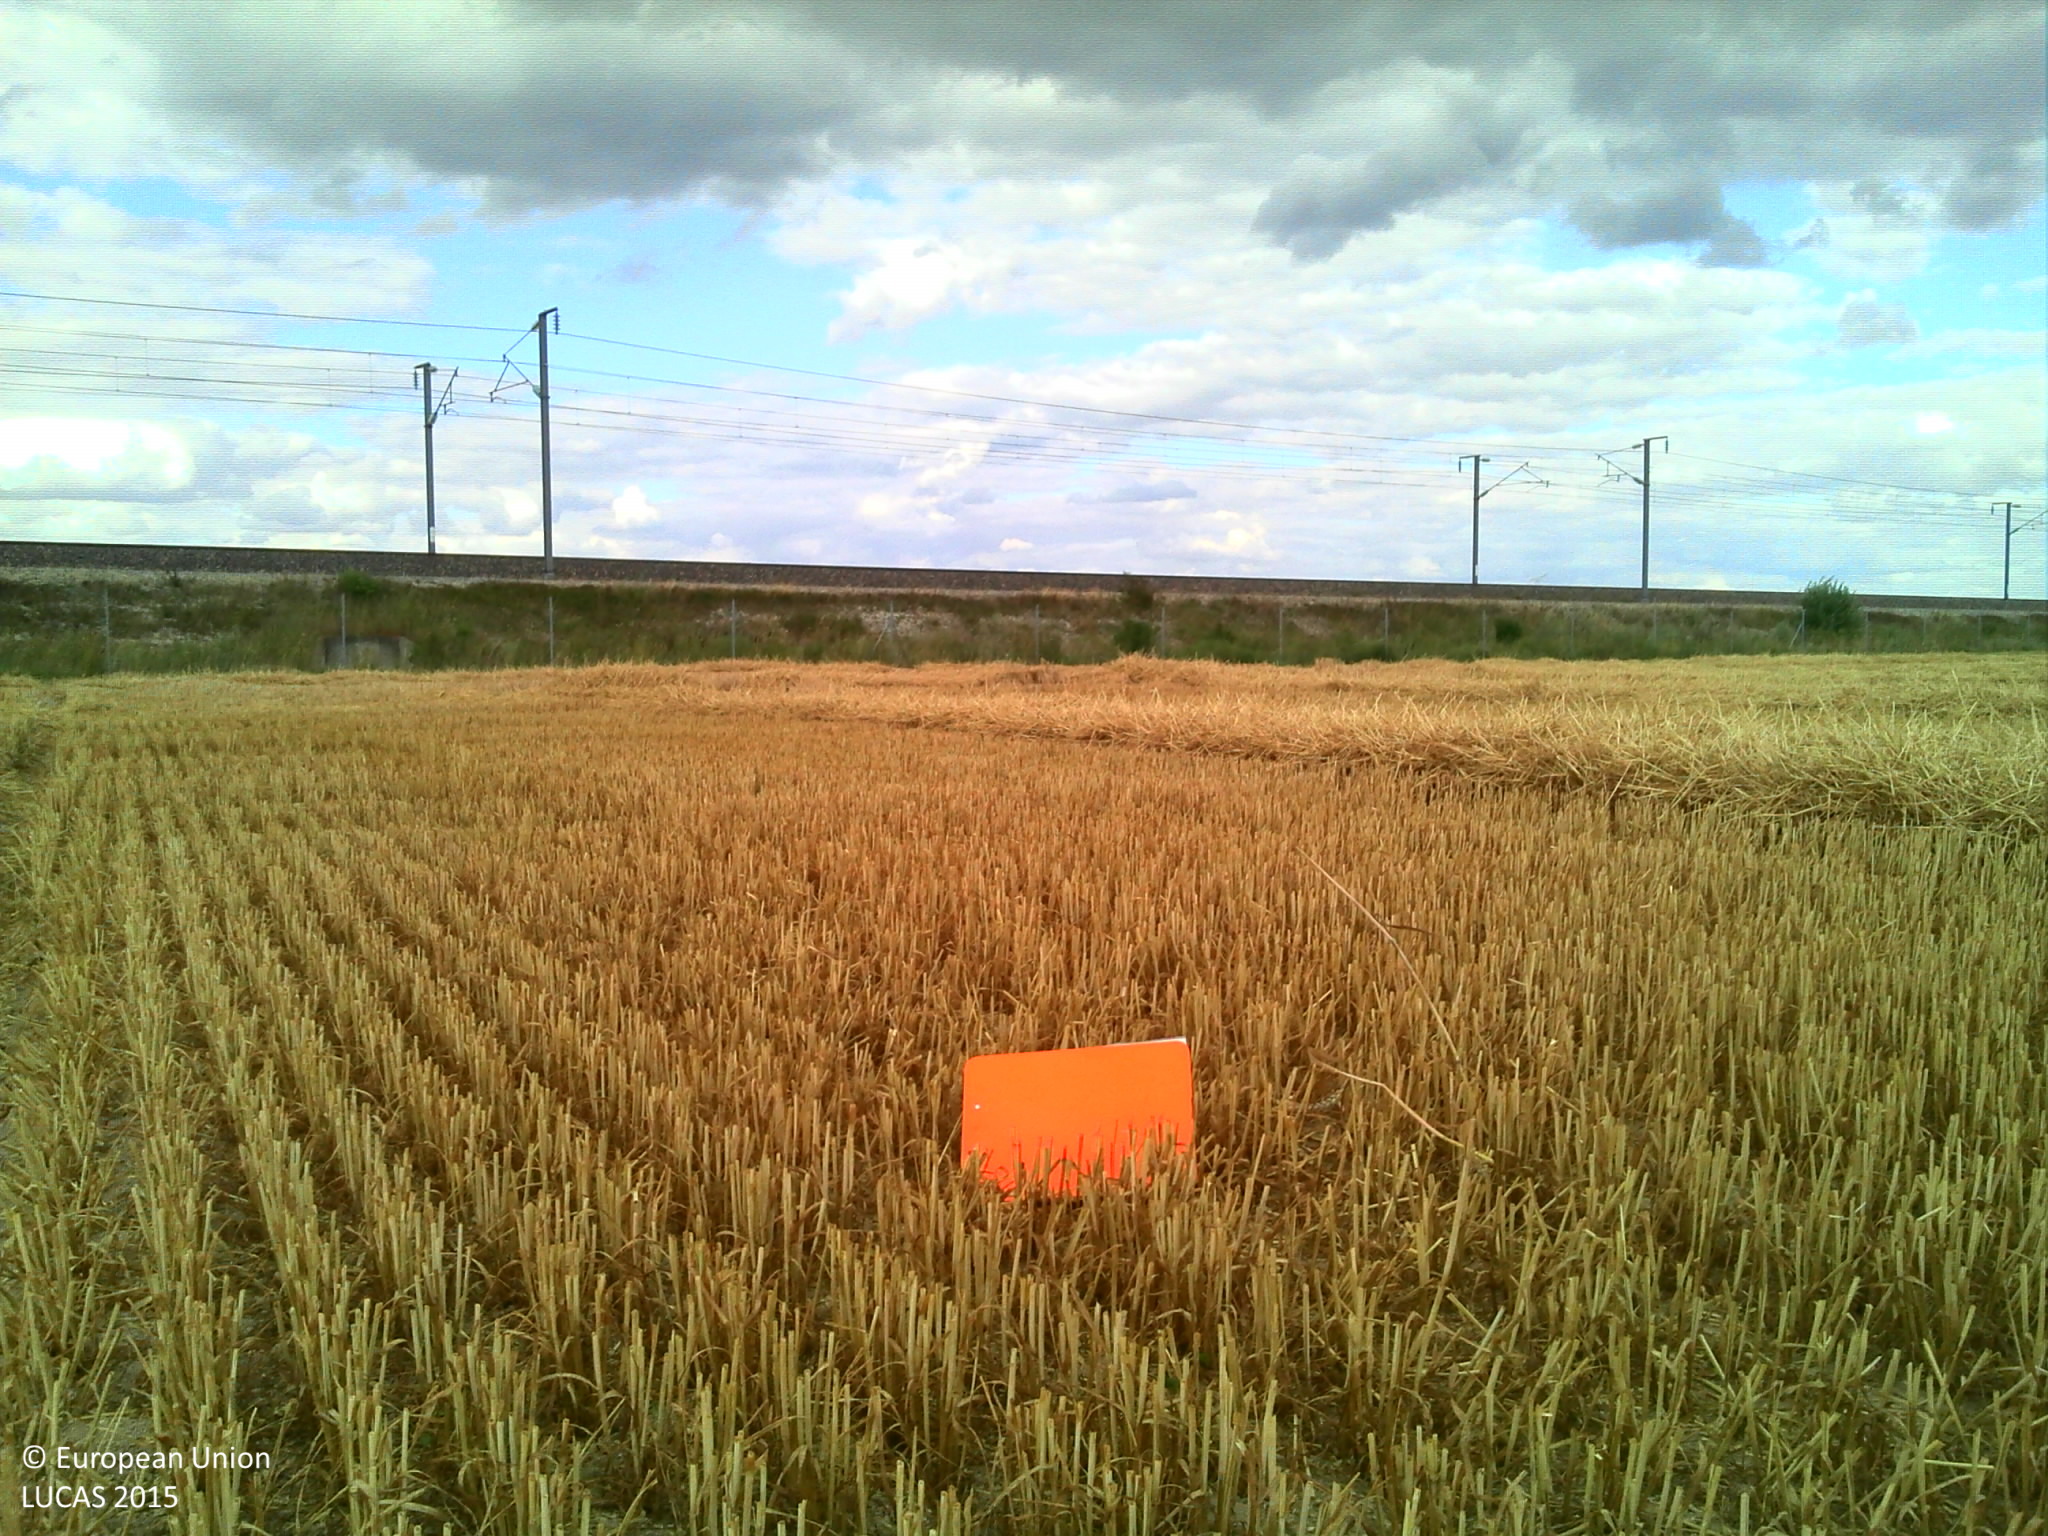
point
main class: Cropland
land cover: Common wheat
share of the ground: > 75 %
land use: Agriculture (excluding fallow land and kitchen gardens)
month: July
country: FR
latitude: 49.0868
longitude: 4.3136
